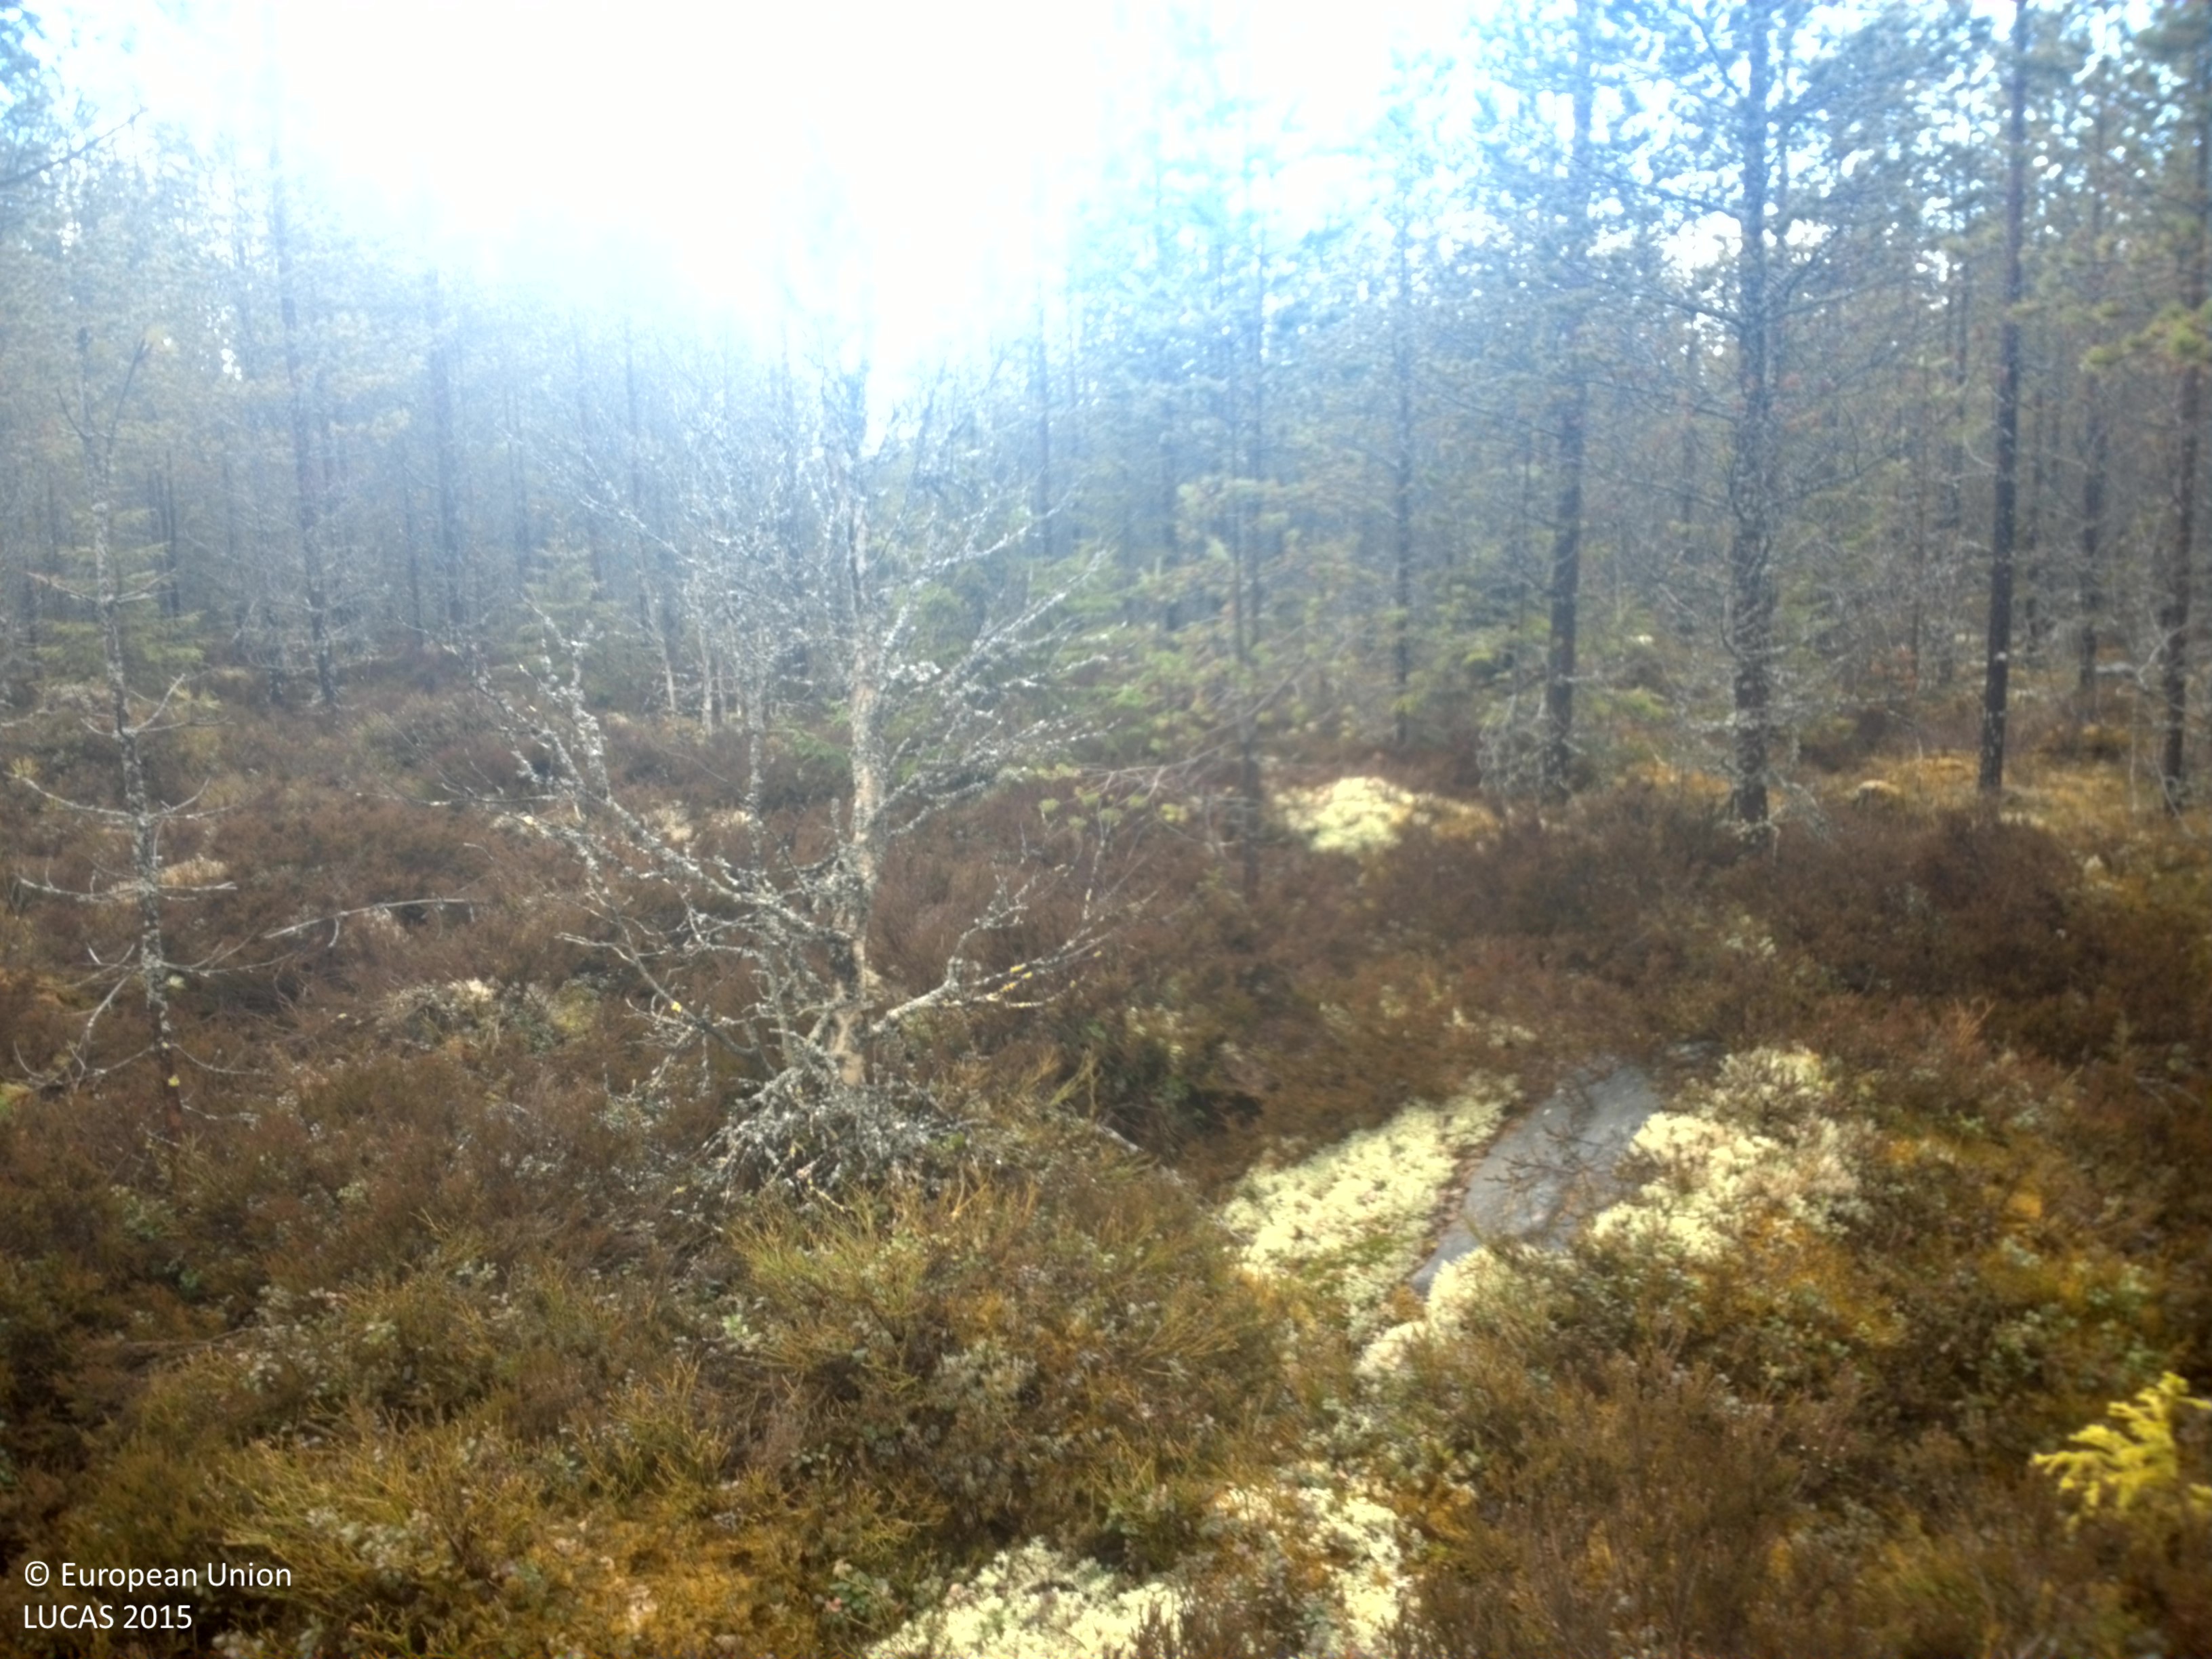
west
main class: Woodland
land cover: Pine dominated coniferous woodland
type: boreal forest
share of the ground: 50 - 75 %
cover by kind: coniferous forest trees 75 %, shrubs 25 %
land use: Forestry
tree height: < 5 m
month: May
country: SE
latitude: 60.9659
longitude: 13.5166
